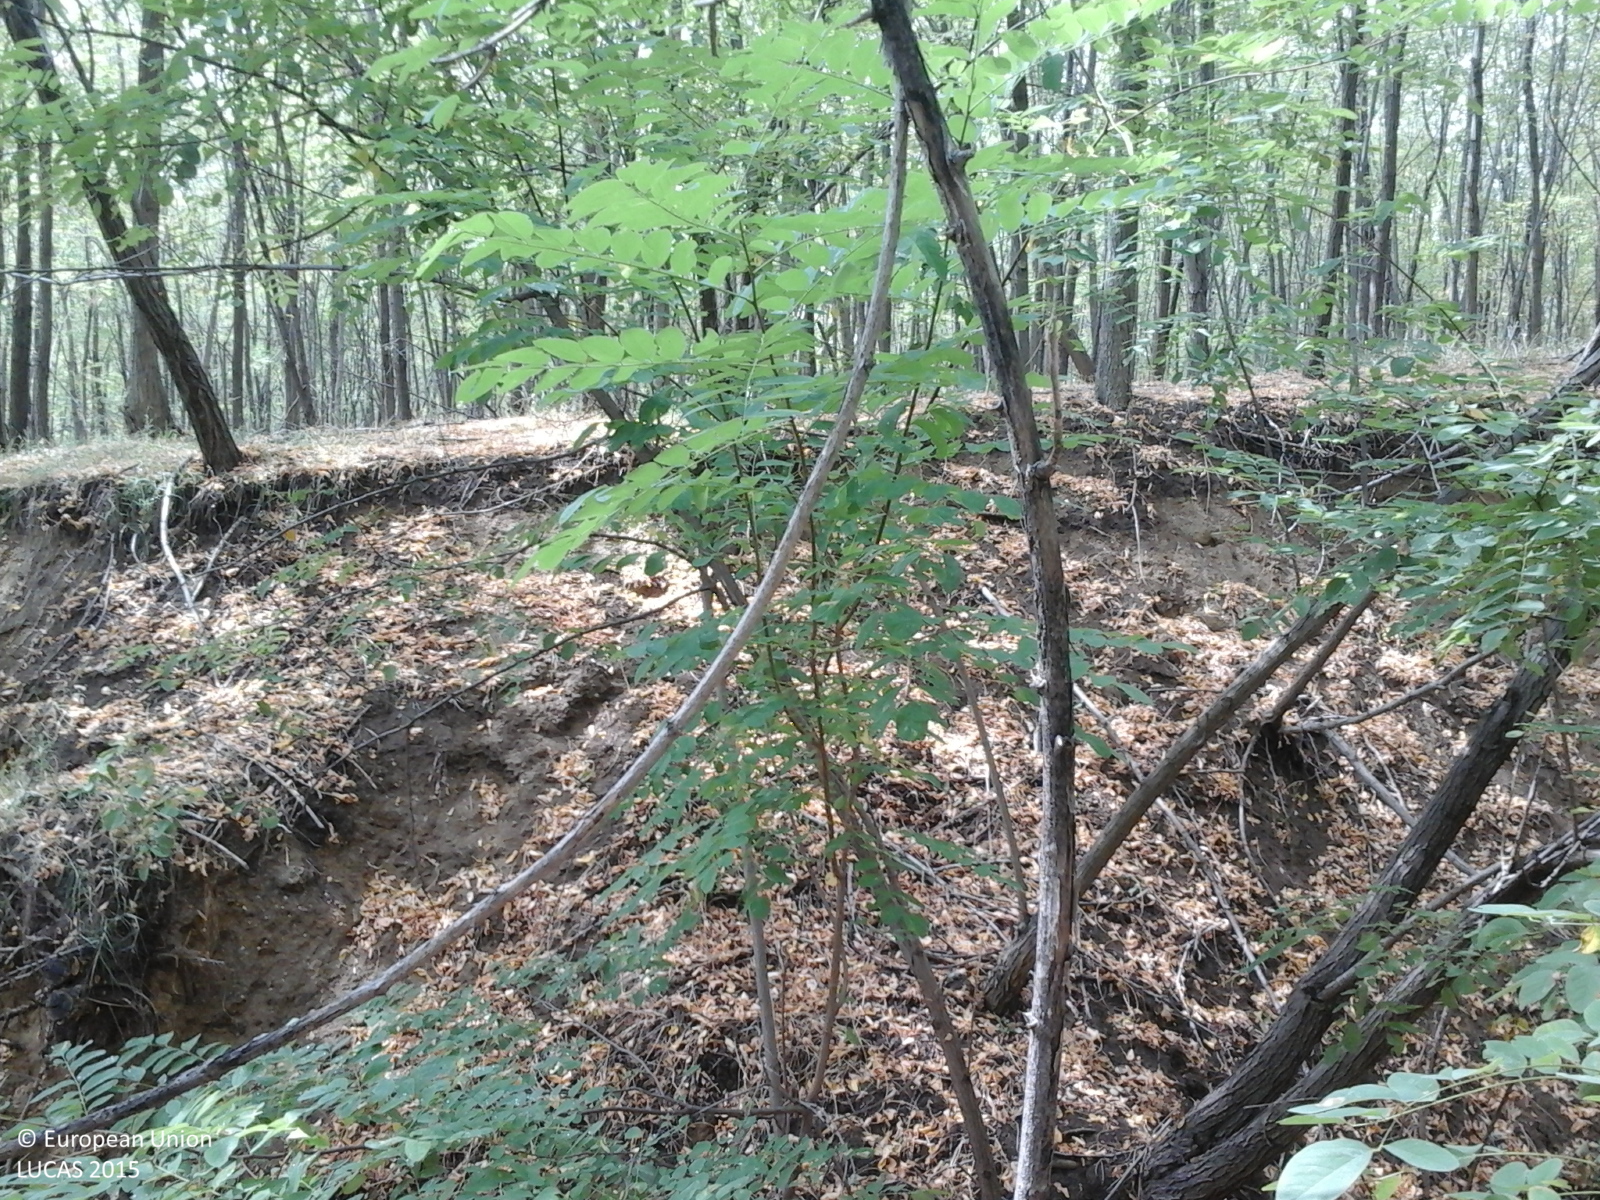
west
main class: Woodland
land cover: Broadleaved woodland
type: exotic forest
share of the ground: > 75 %
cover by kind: broadleaved forest trees 100 %
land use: Forestry
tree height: > 5 m
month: August
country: RO
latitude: 44.6558
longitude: 22.7418
